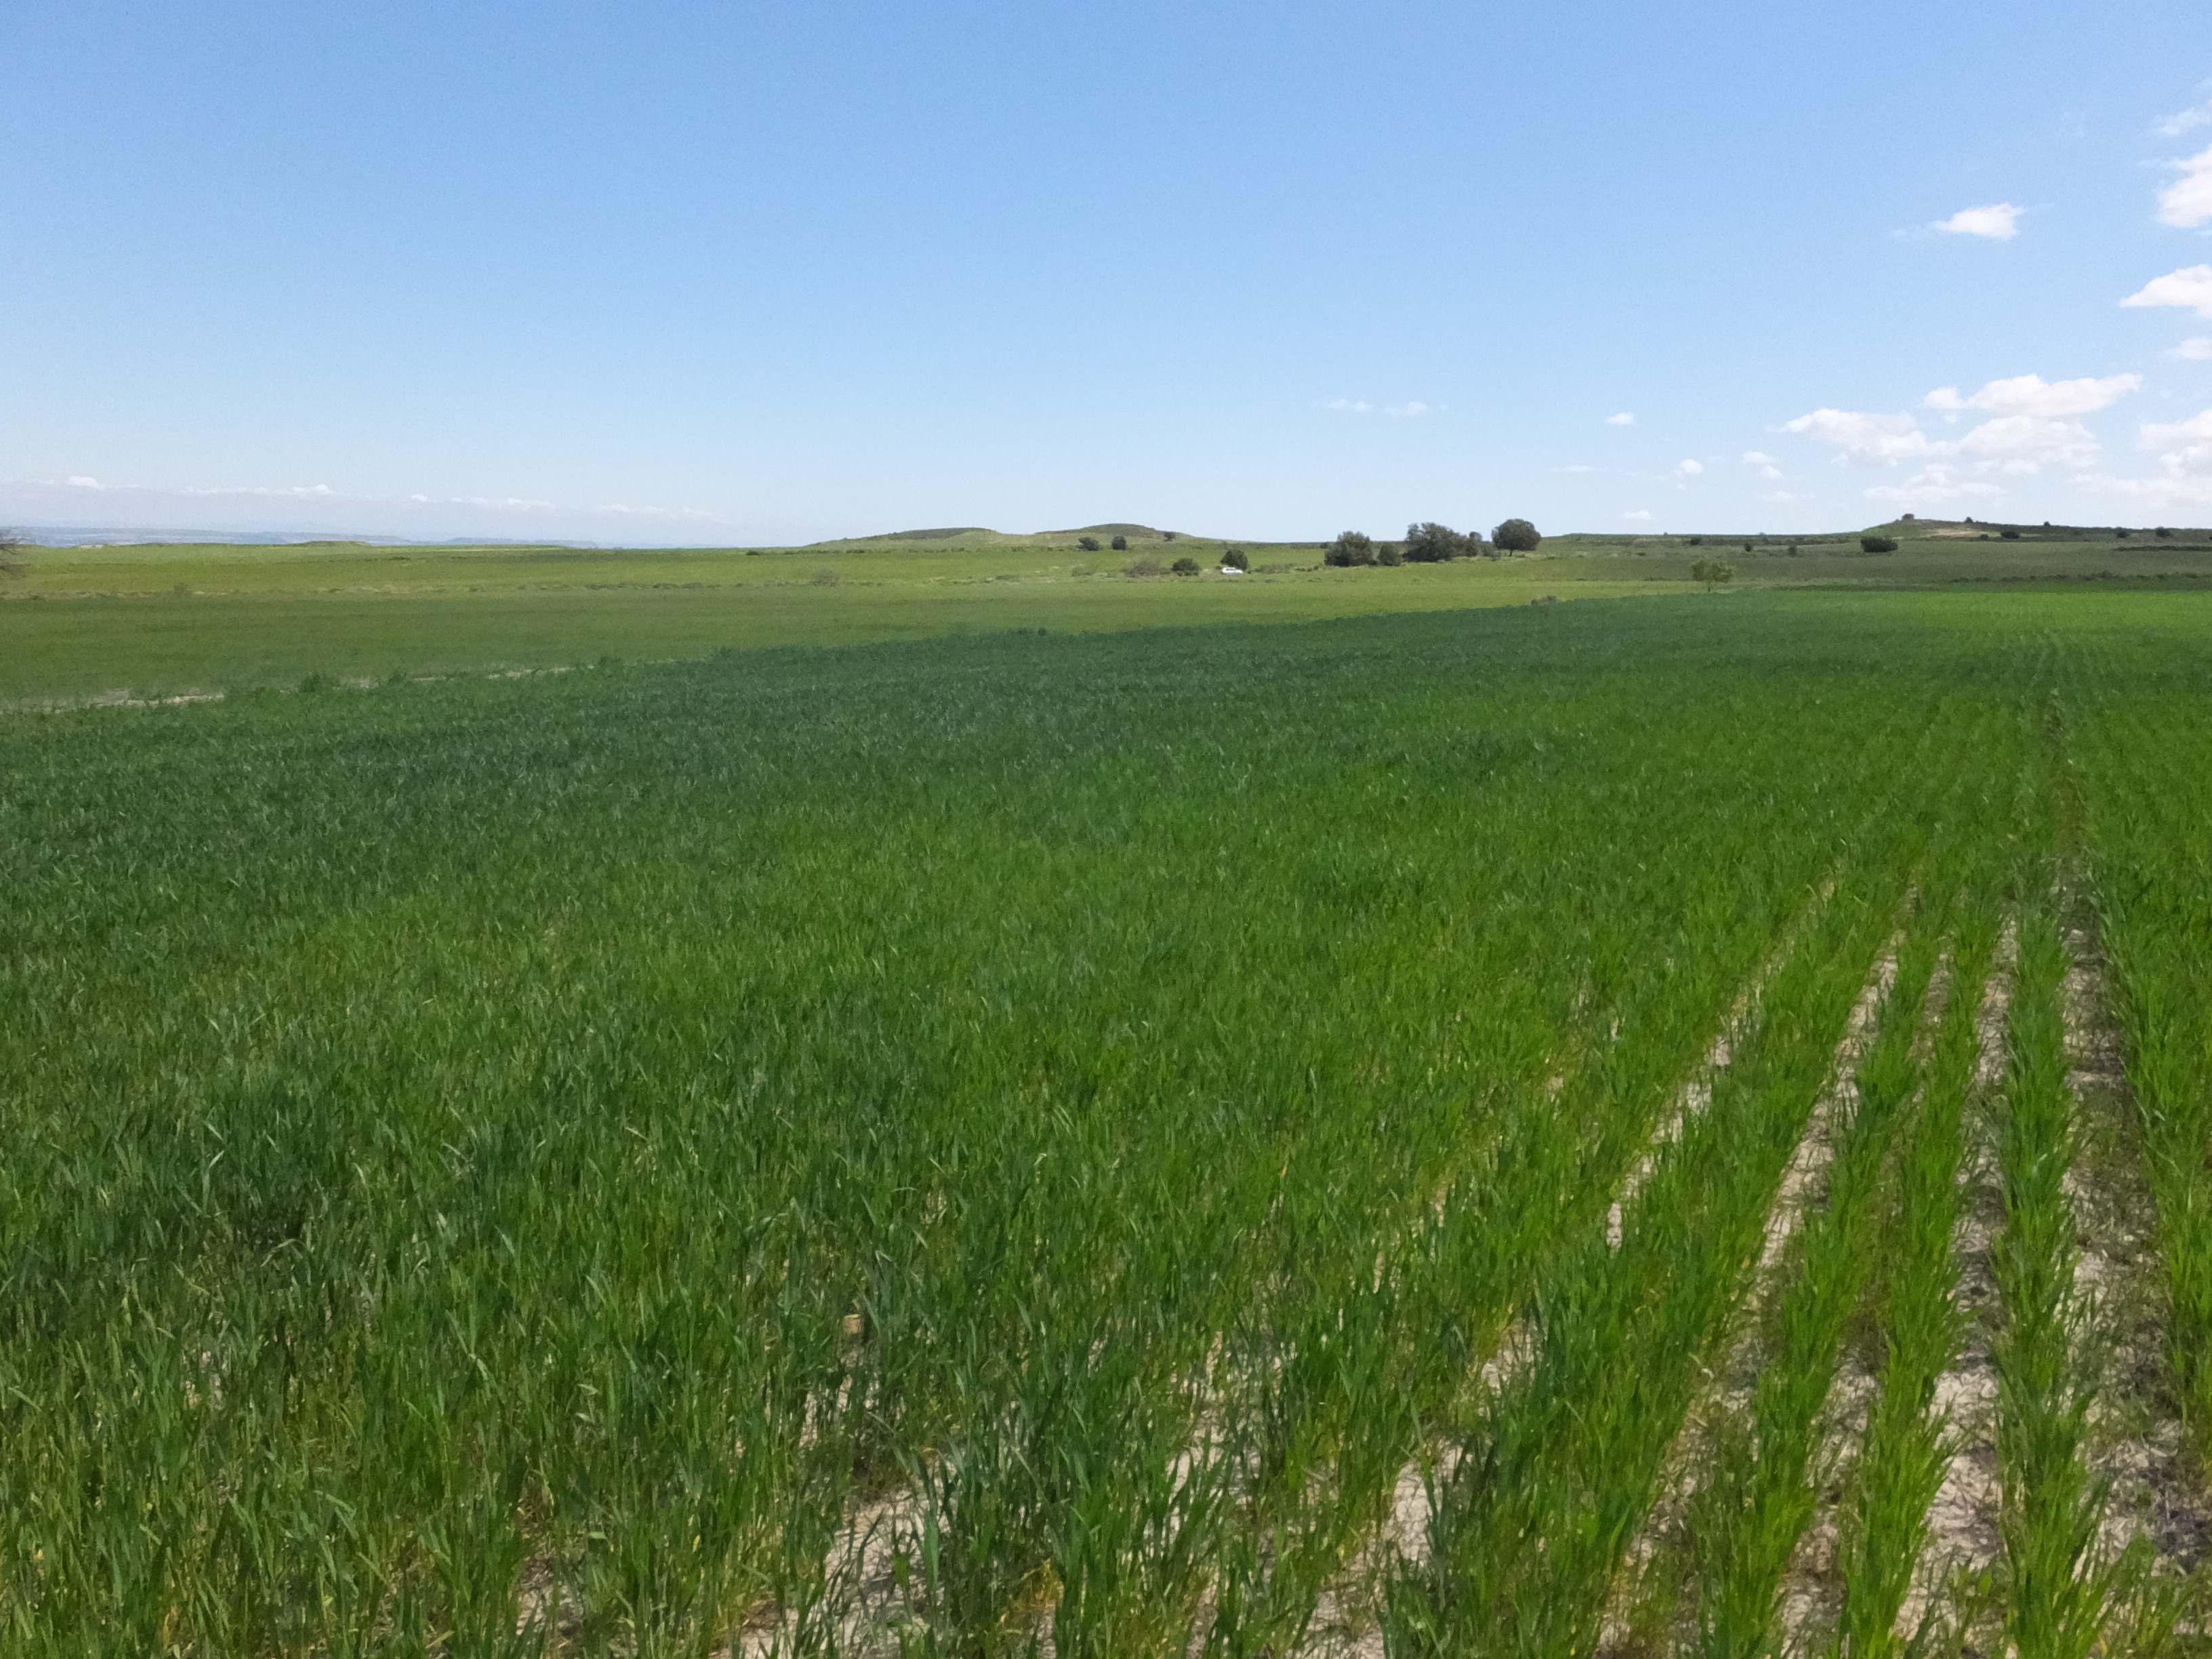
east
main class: Cropland
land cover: Barley
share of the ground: > 75 %
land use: Agriculture (excluding fallow land and kitchen gardens)
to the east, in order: Barley; Shruby margins; Barley; Shruby margins; Barley
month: April
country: ES
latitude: 41.7072
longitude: -0.3176
